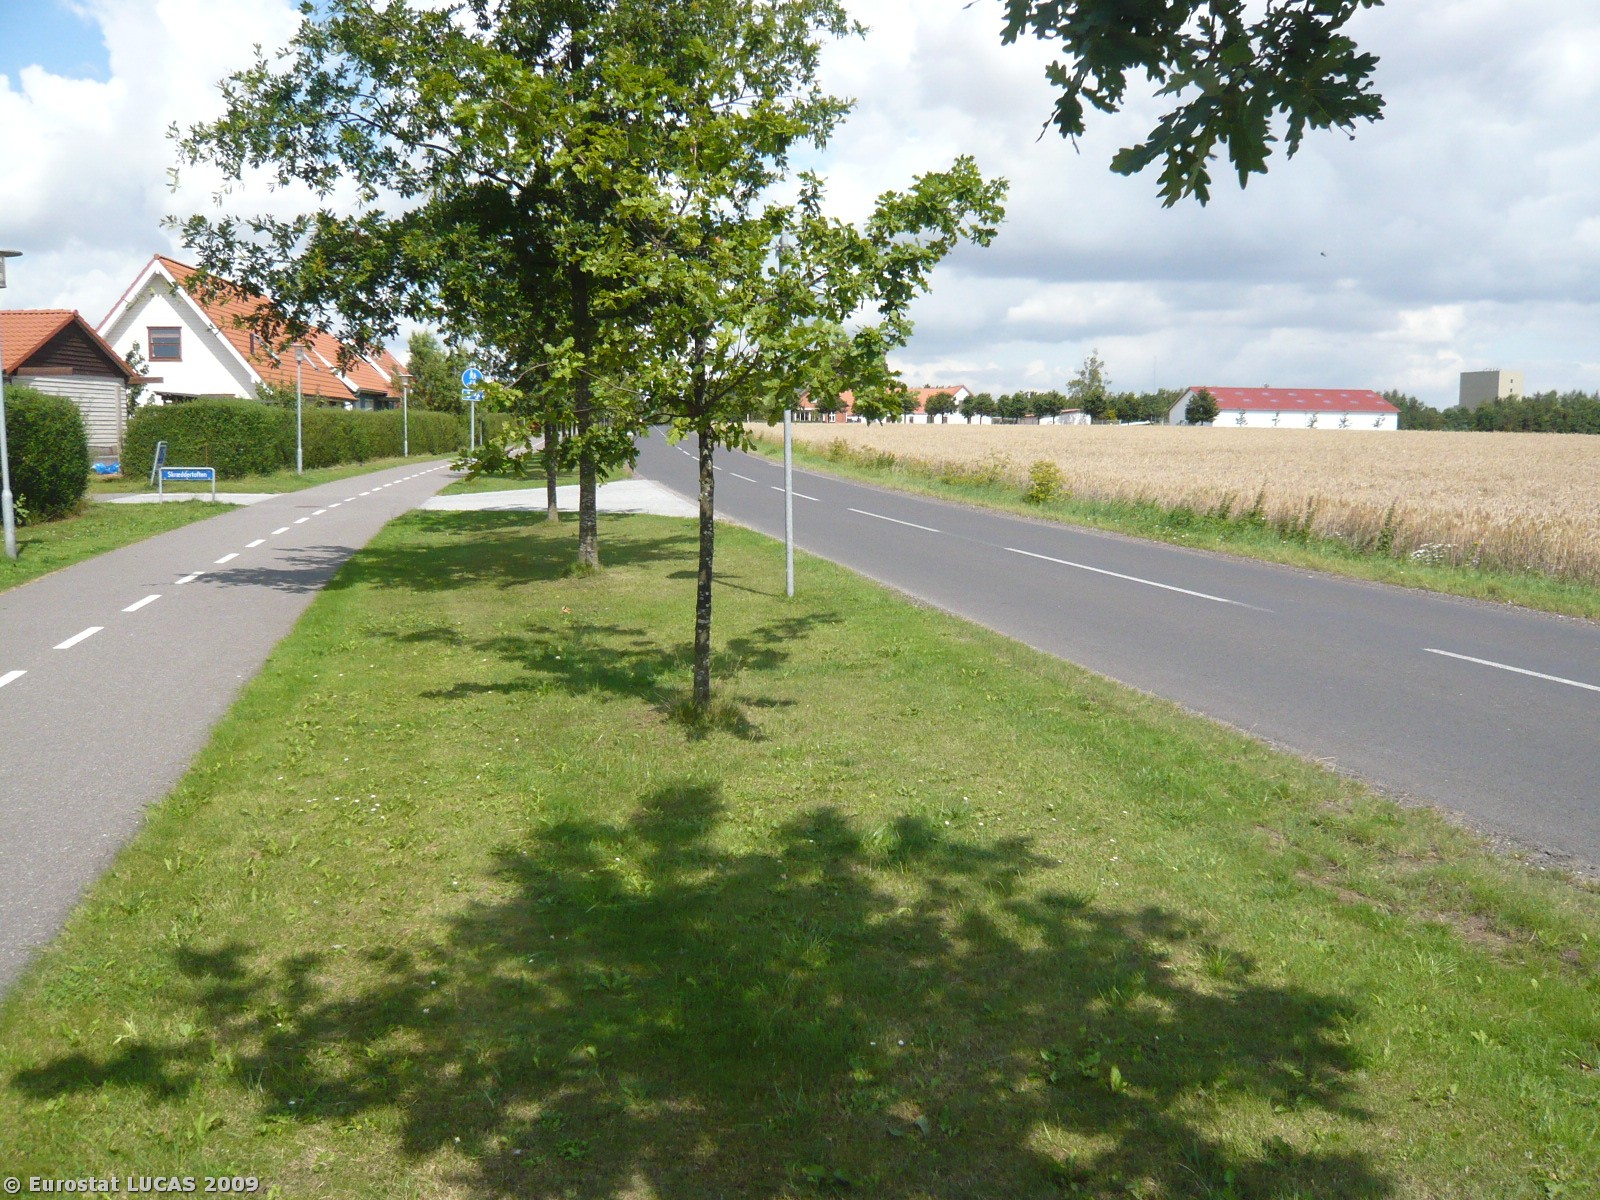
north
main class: Artificial land
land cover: Non built-up linear features
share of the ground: > 75 %
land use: Road transport
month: July
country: DK
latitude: 55.5047
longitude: 12.1357
